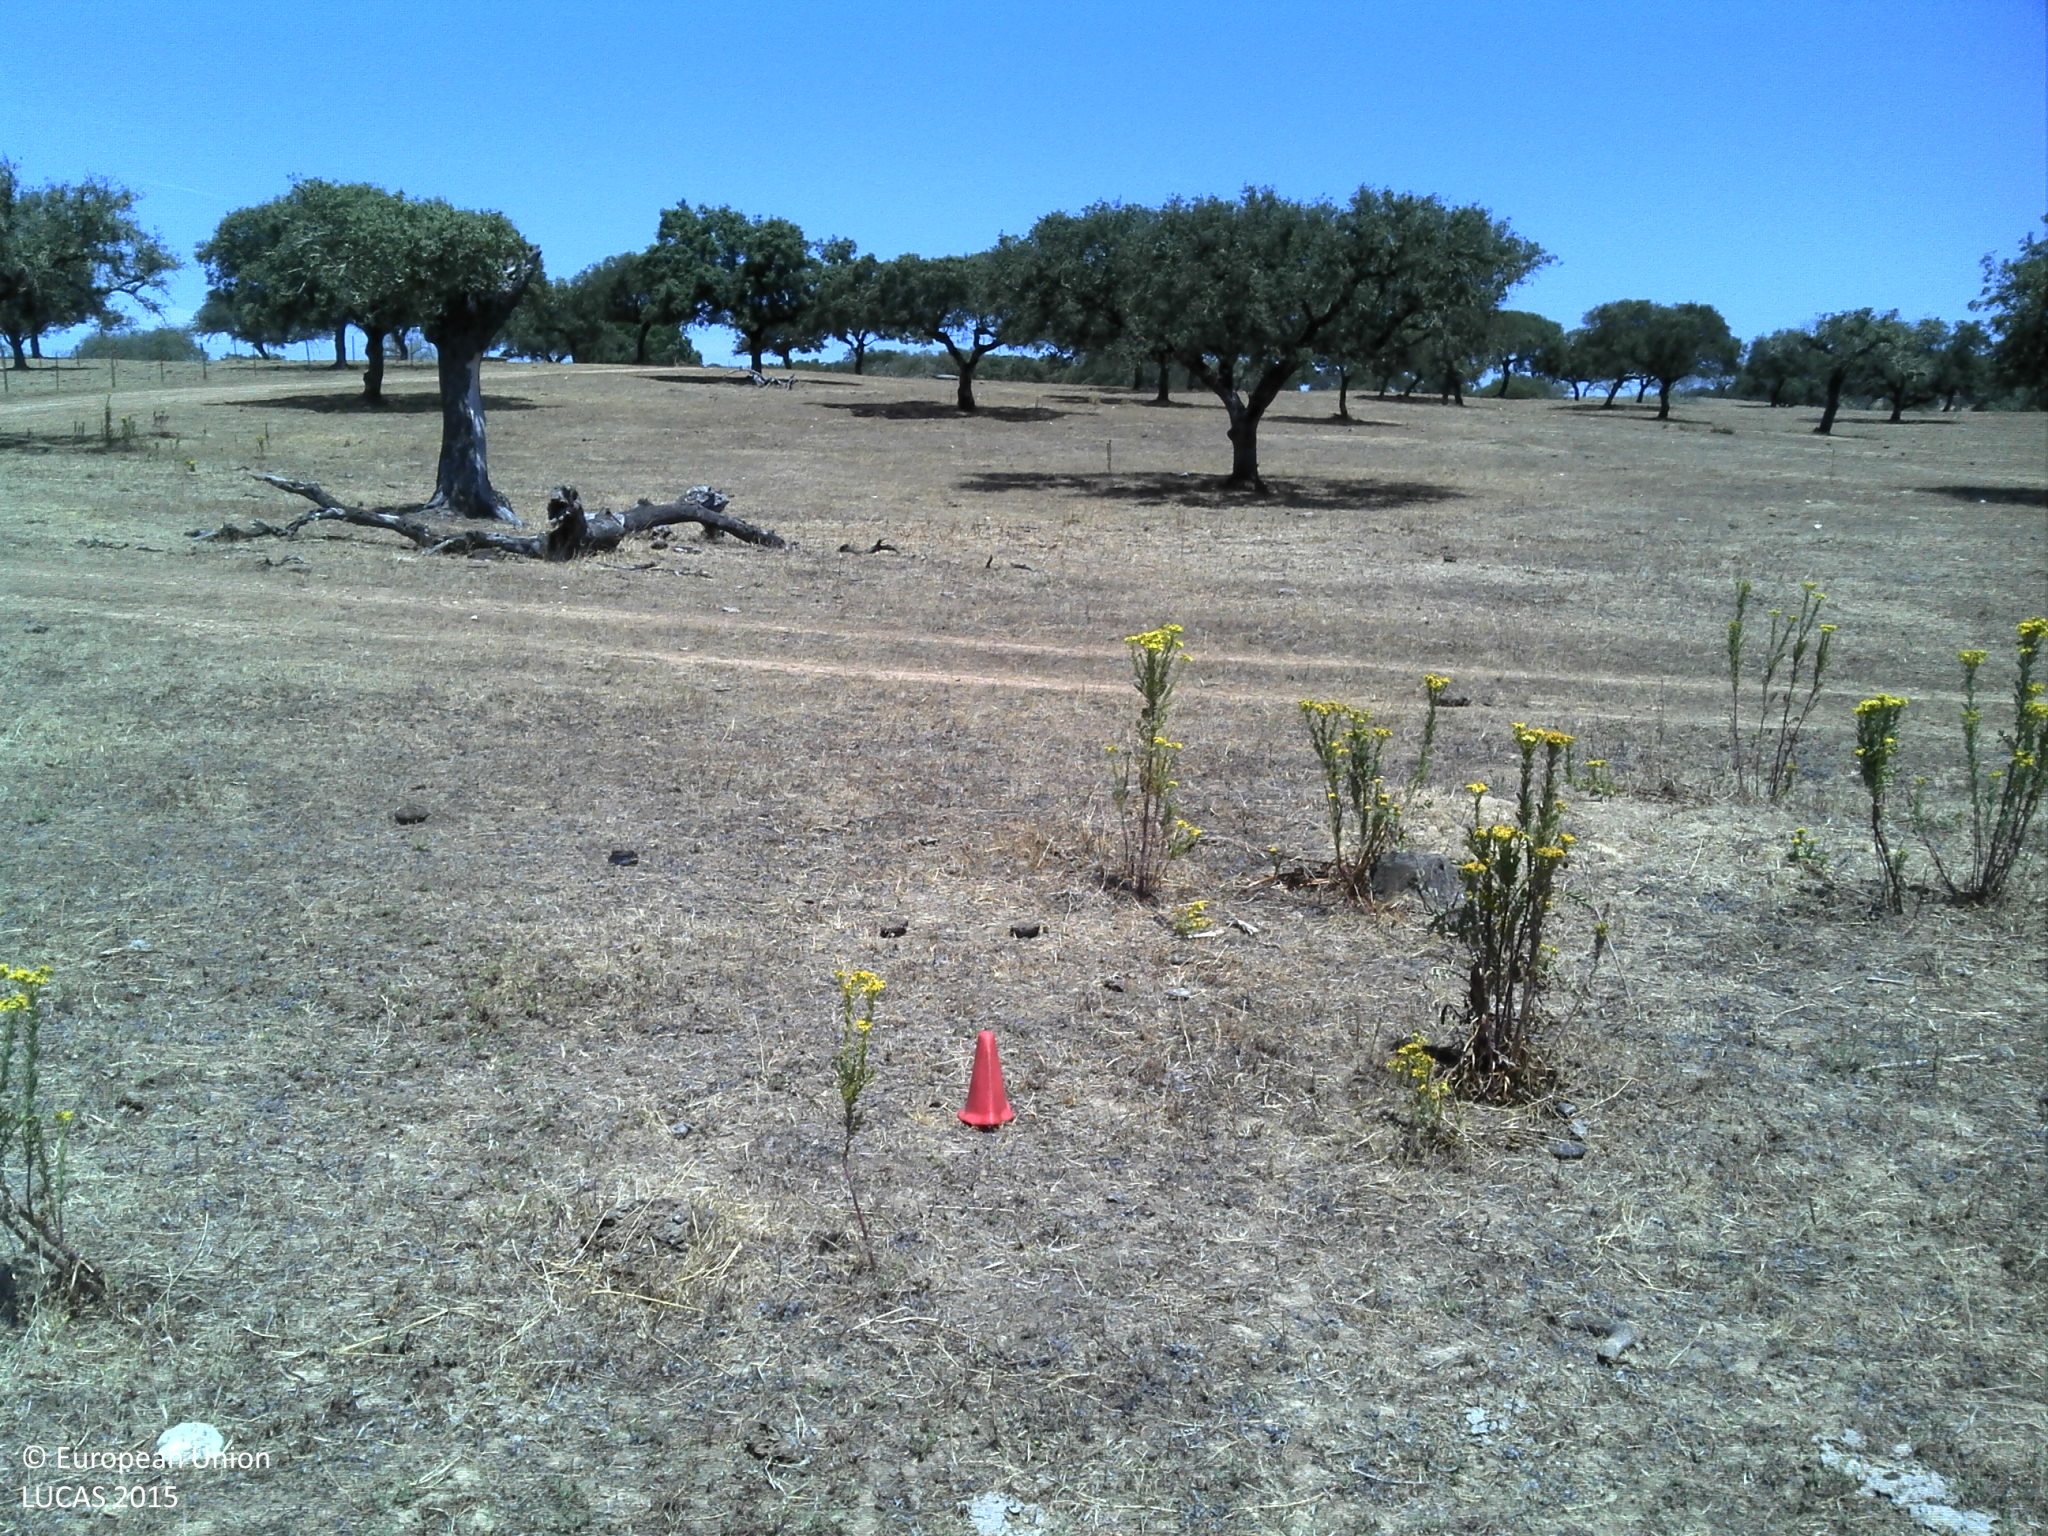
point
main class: Grassland
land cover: Grassland without tree/shrub cover
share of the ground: 25 - 50 %
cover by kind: unconsolidated bare surface 70 %, herbaceous plants 30 %
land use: Agriculture (excluding fallow land and kitchen gardens)
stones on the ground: < 10 %
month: June
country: PT
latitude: 37.8834
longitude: -7.5155
